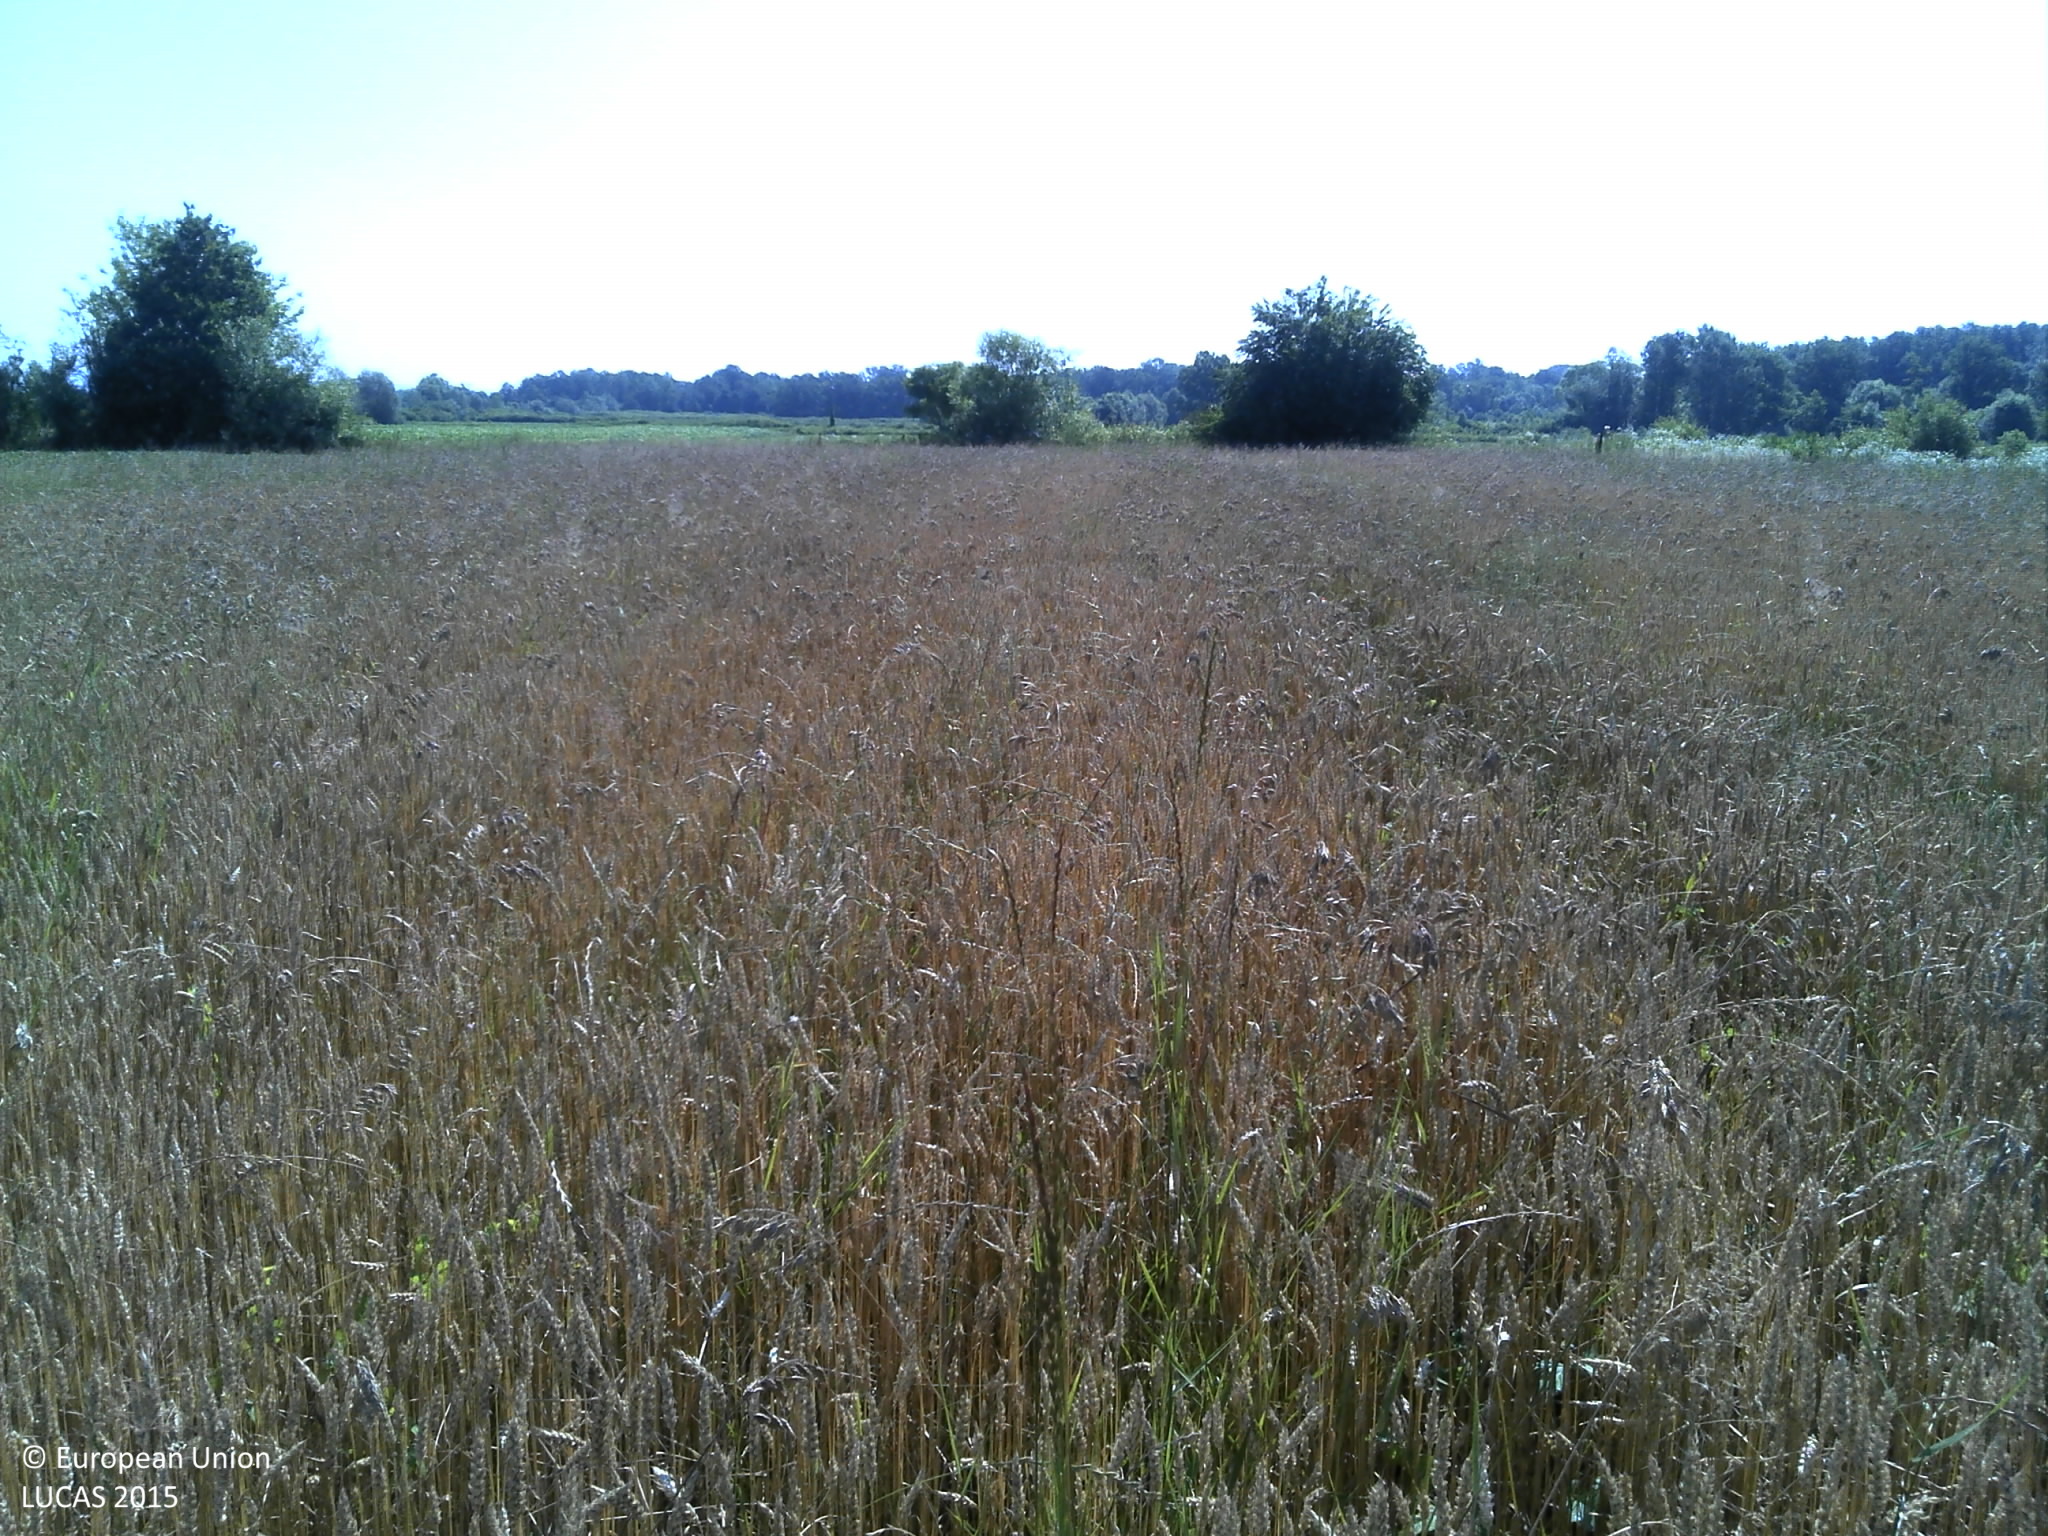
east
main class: Cropland
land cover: Common wheat
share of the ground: > 75 %
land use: Agriculture (excluding fallow land and kitchen gardens)
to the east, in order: Common wheat; Single bushes/trees; Grass margins; Tracks; Grass margins; Maize
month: June
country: HR
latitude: 45.1906
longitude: 17.3950
